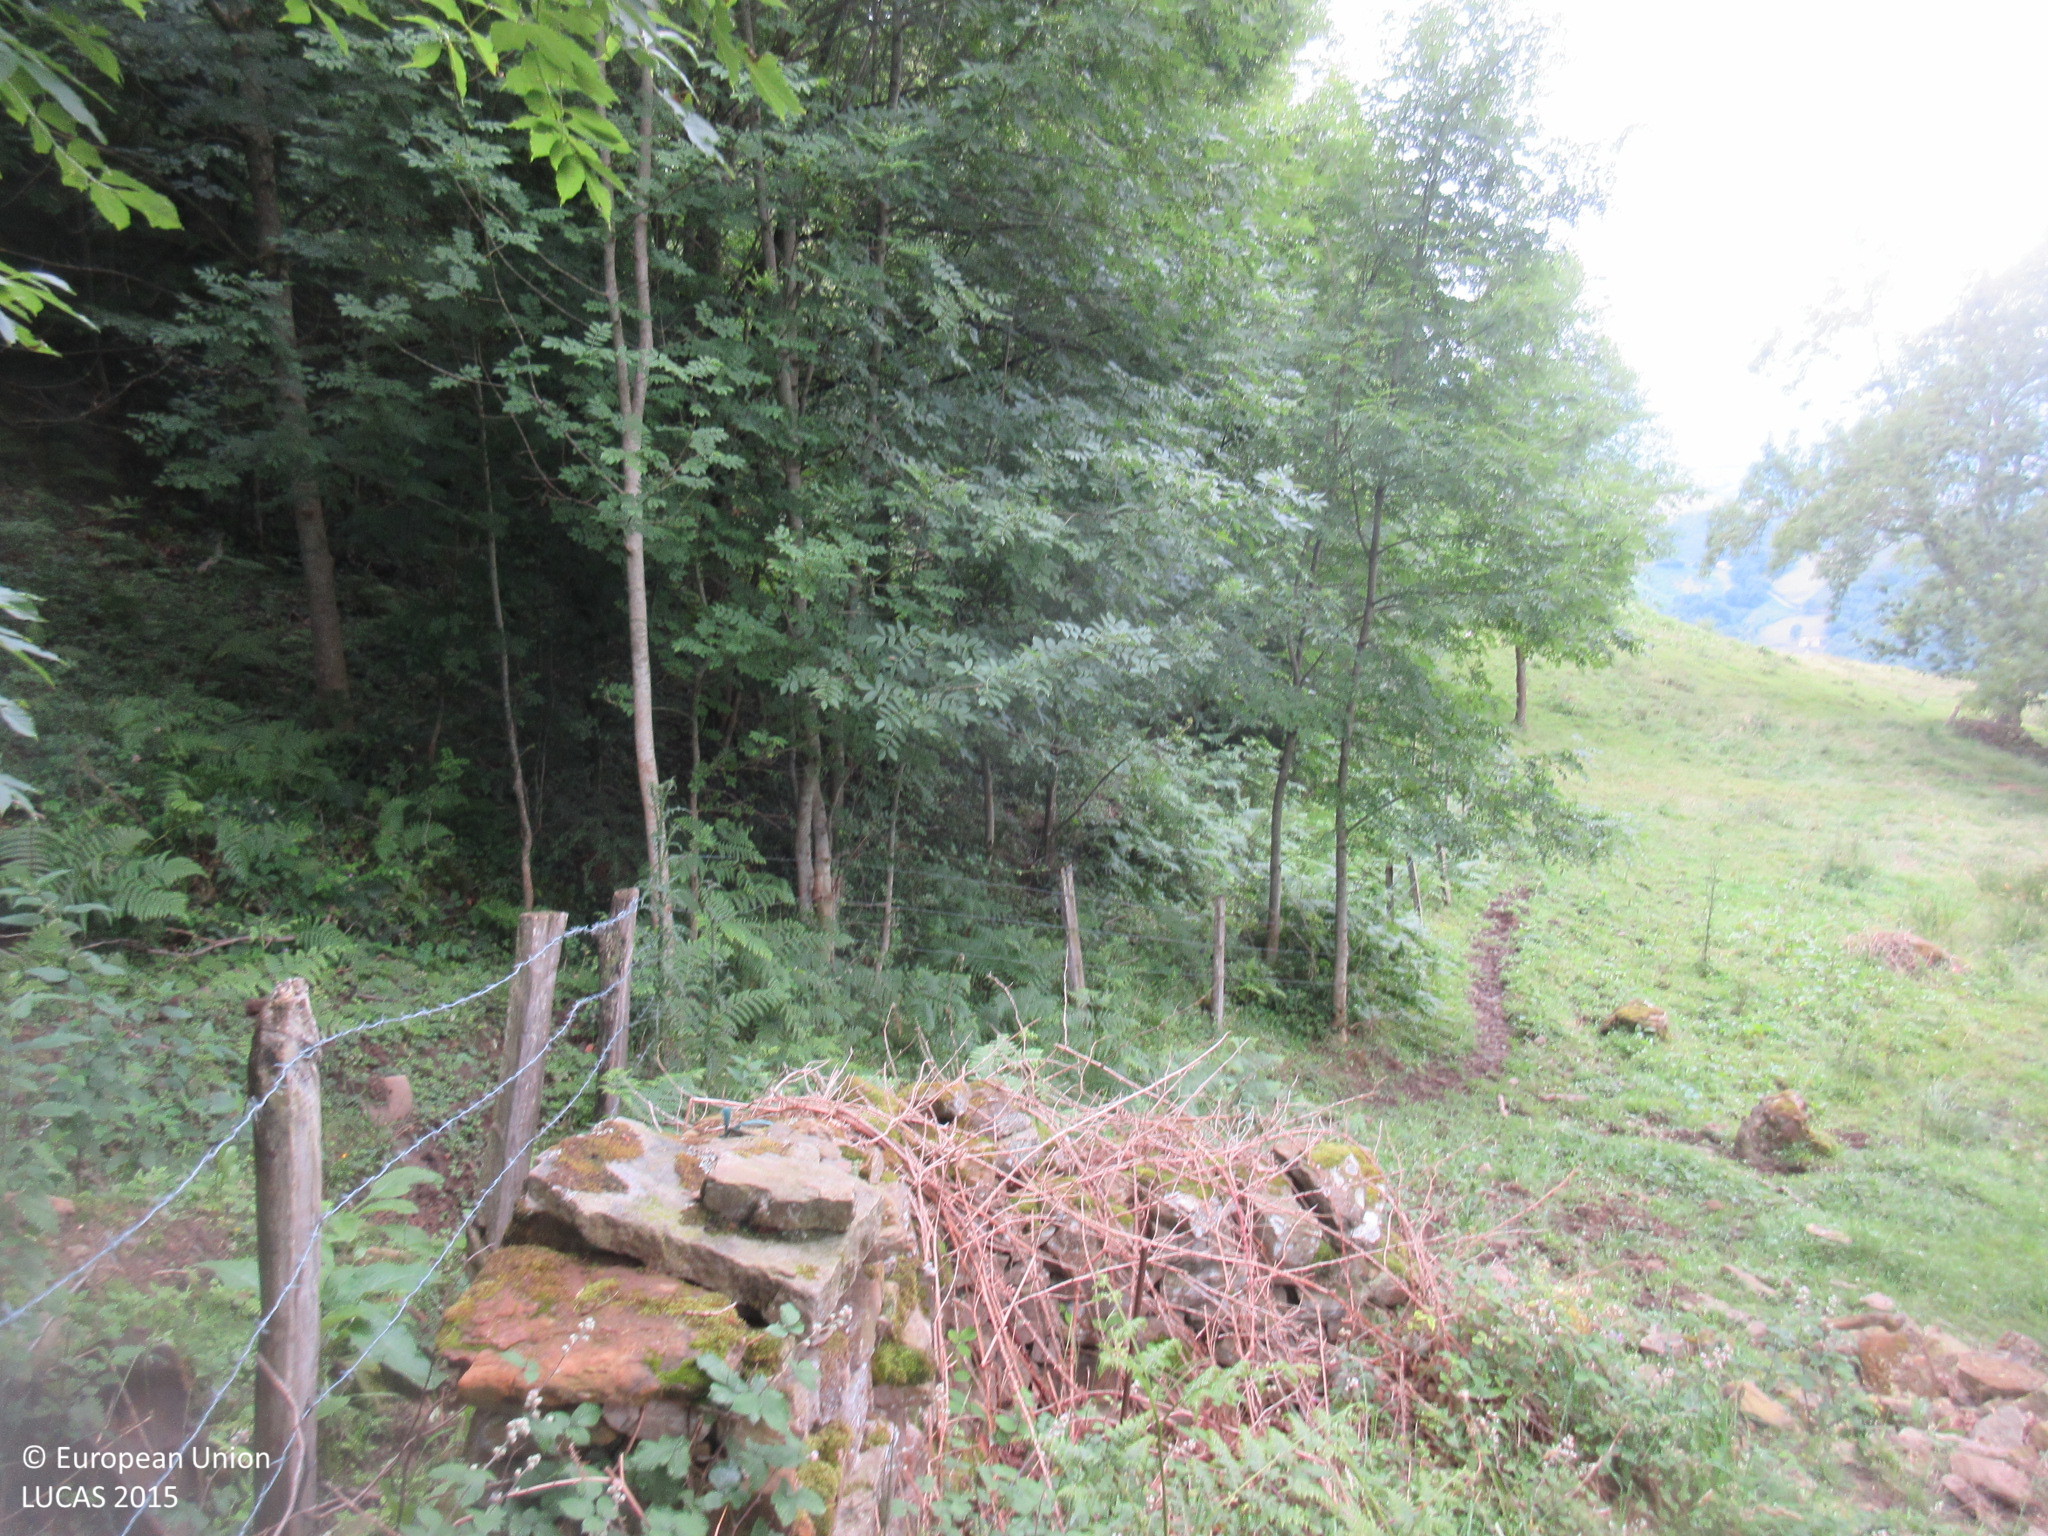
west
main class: Woodland
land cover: Broadleaved woodland
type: thermophilous deciduous forest
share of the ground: > 75 %
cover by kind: broadleaved forest trees 85 %, shrubs 15 %
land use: Semi-natural and natural areas not in use
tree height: > 5 m
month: July
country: ES
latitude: 43.1522
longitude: -3.5068
